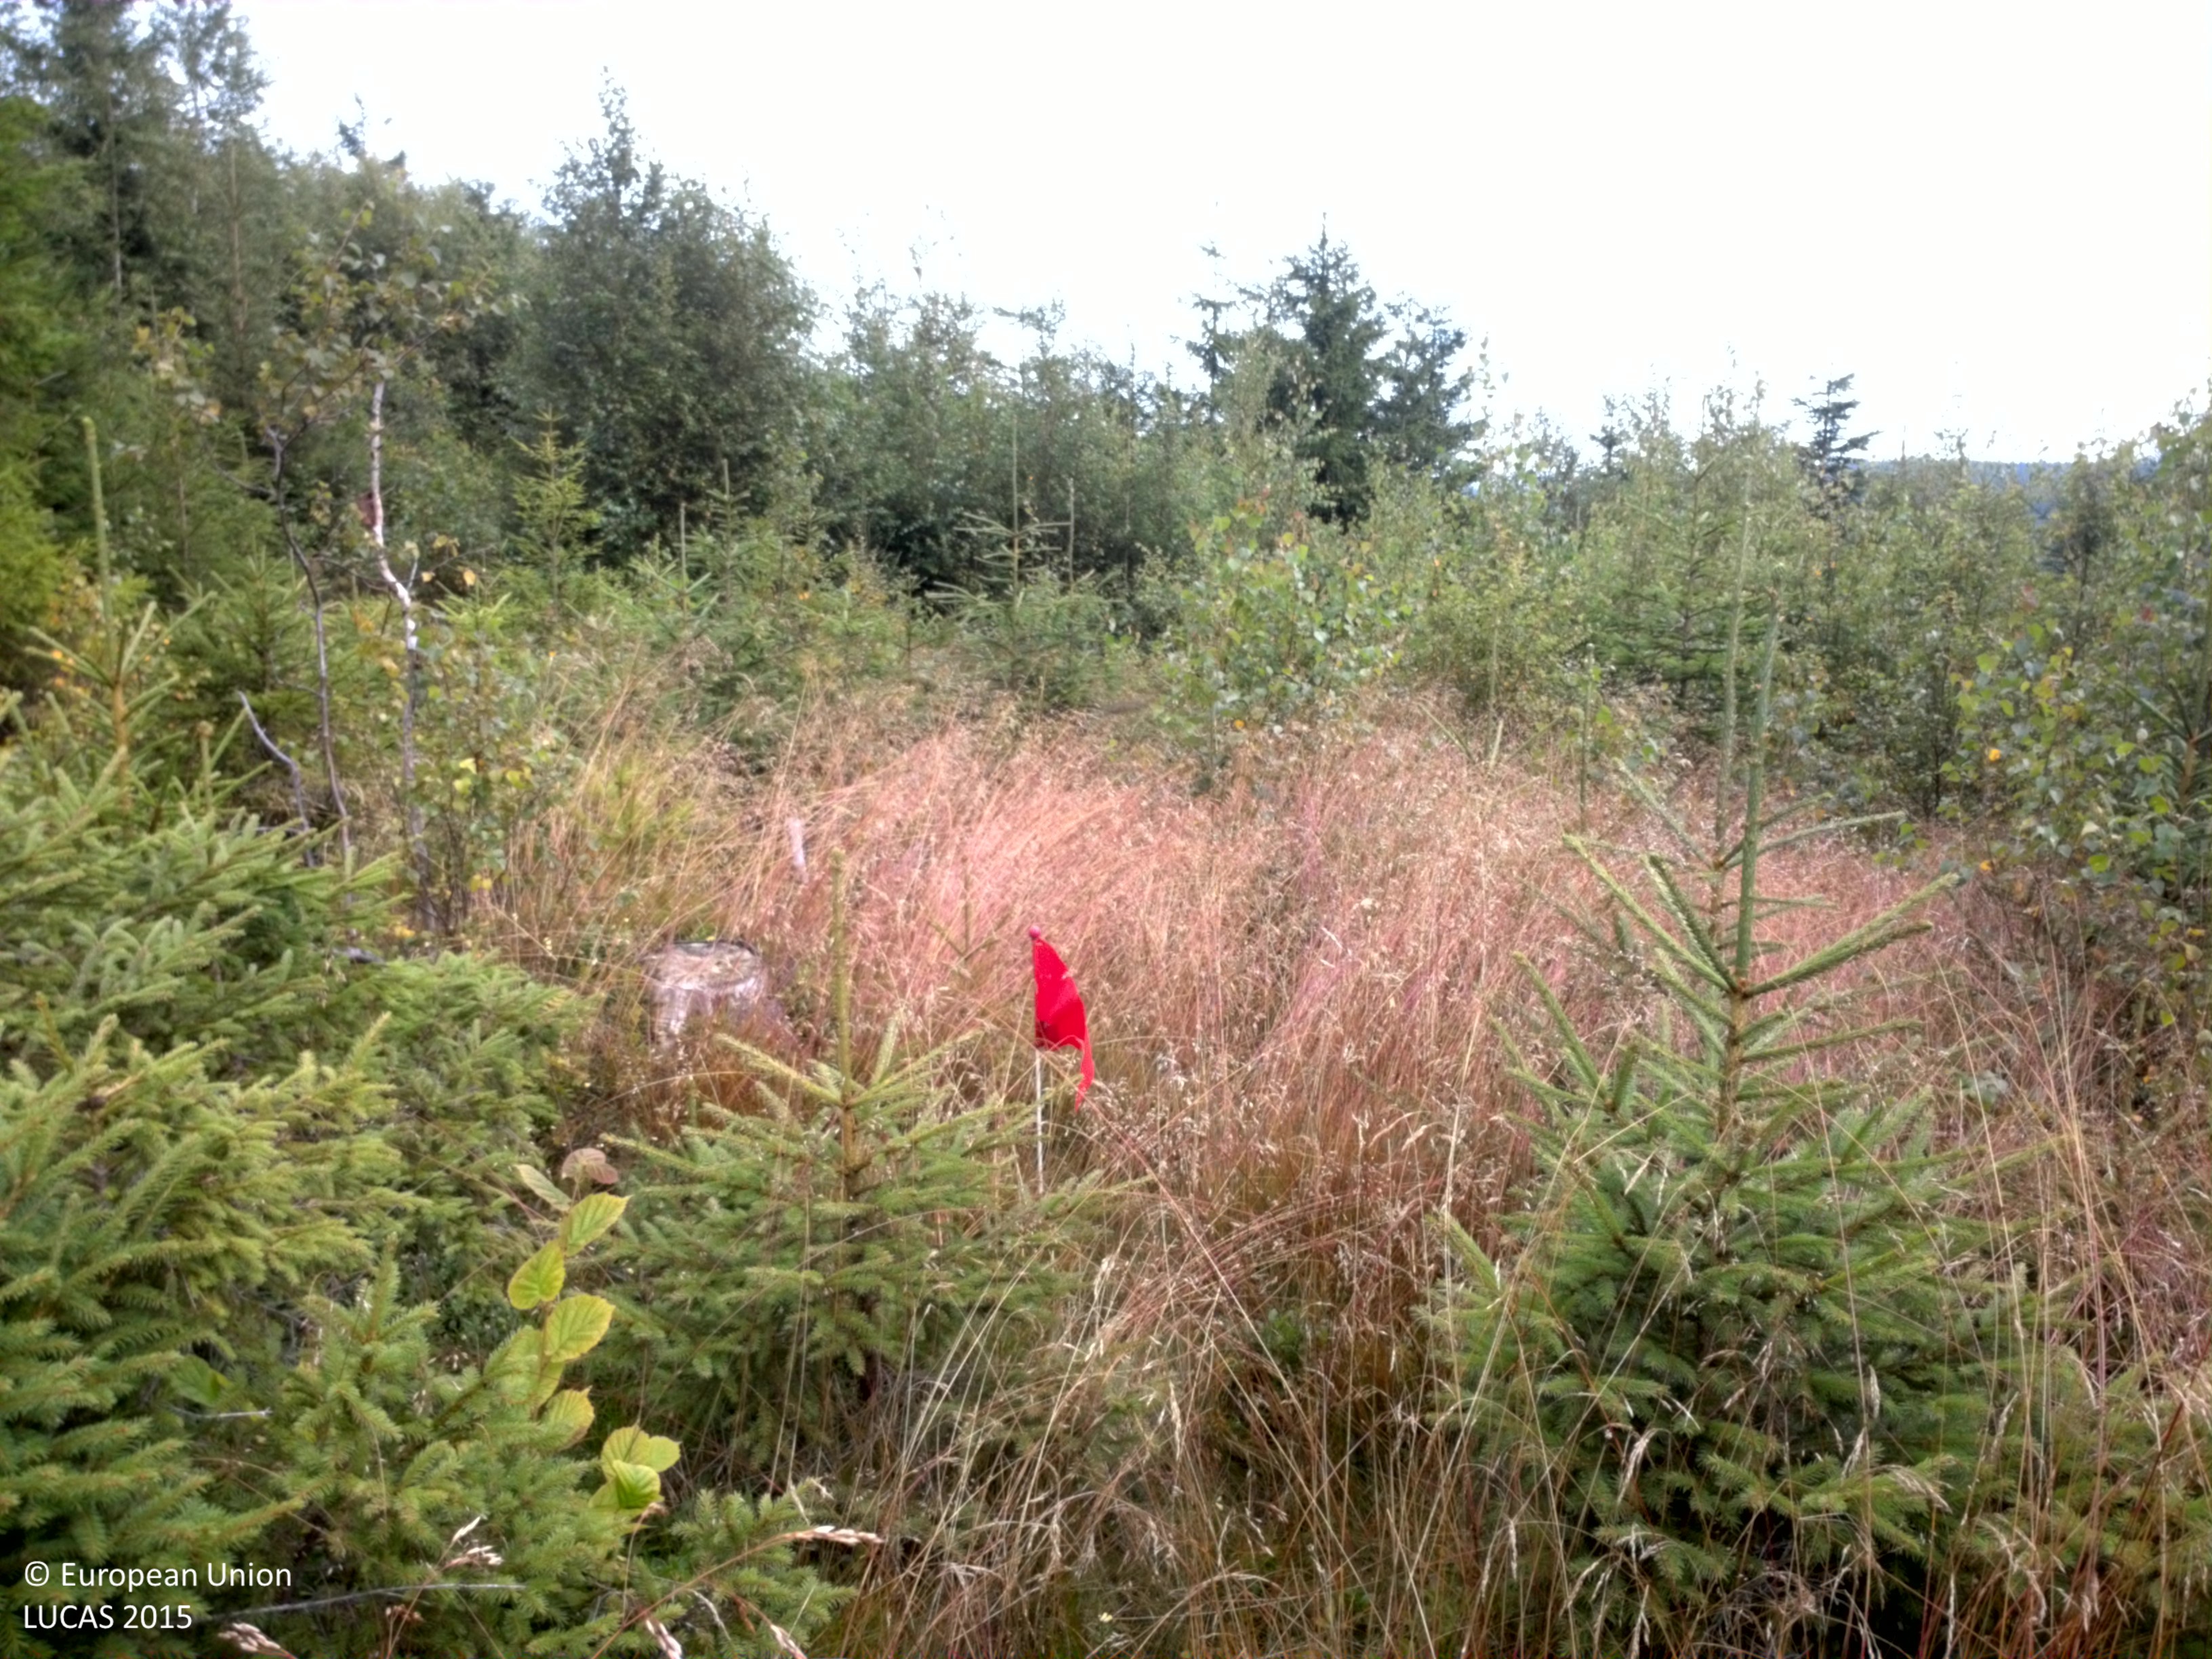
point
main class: Woodland
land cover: Spruce dominated mixed woodland
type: boreal forest
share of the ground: 25 - 50 %
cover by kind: herbaceous plants 35 %, coniferous forest trees 30 %, broadleaved forest trees 20 %, shrubs 10 %, lichens and mosses 5 %
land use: Forestry
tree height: < 5 m
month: August
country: SE
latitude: 59.6015
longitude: 13.3051
